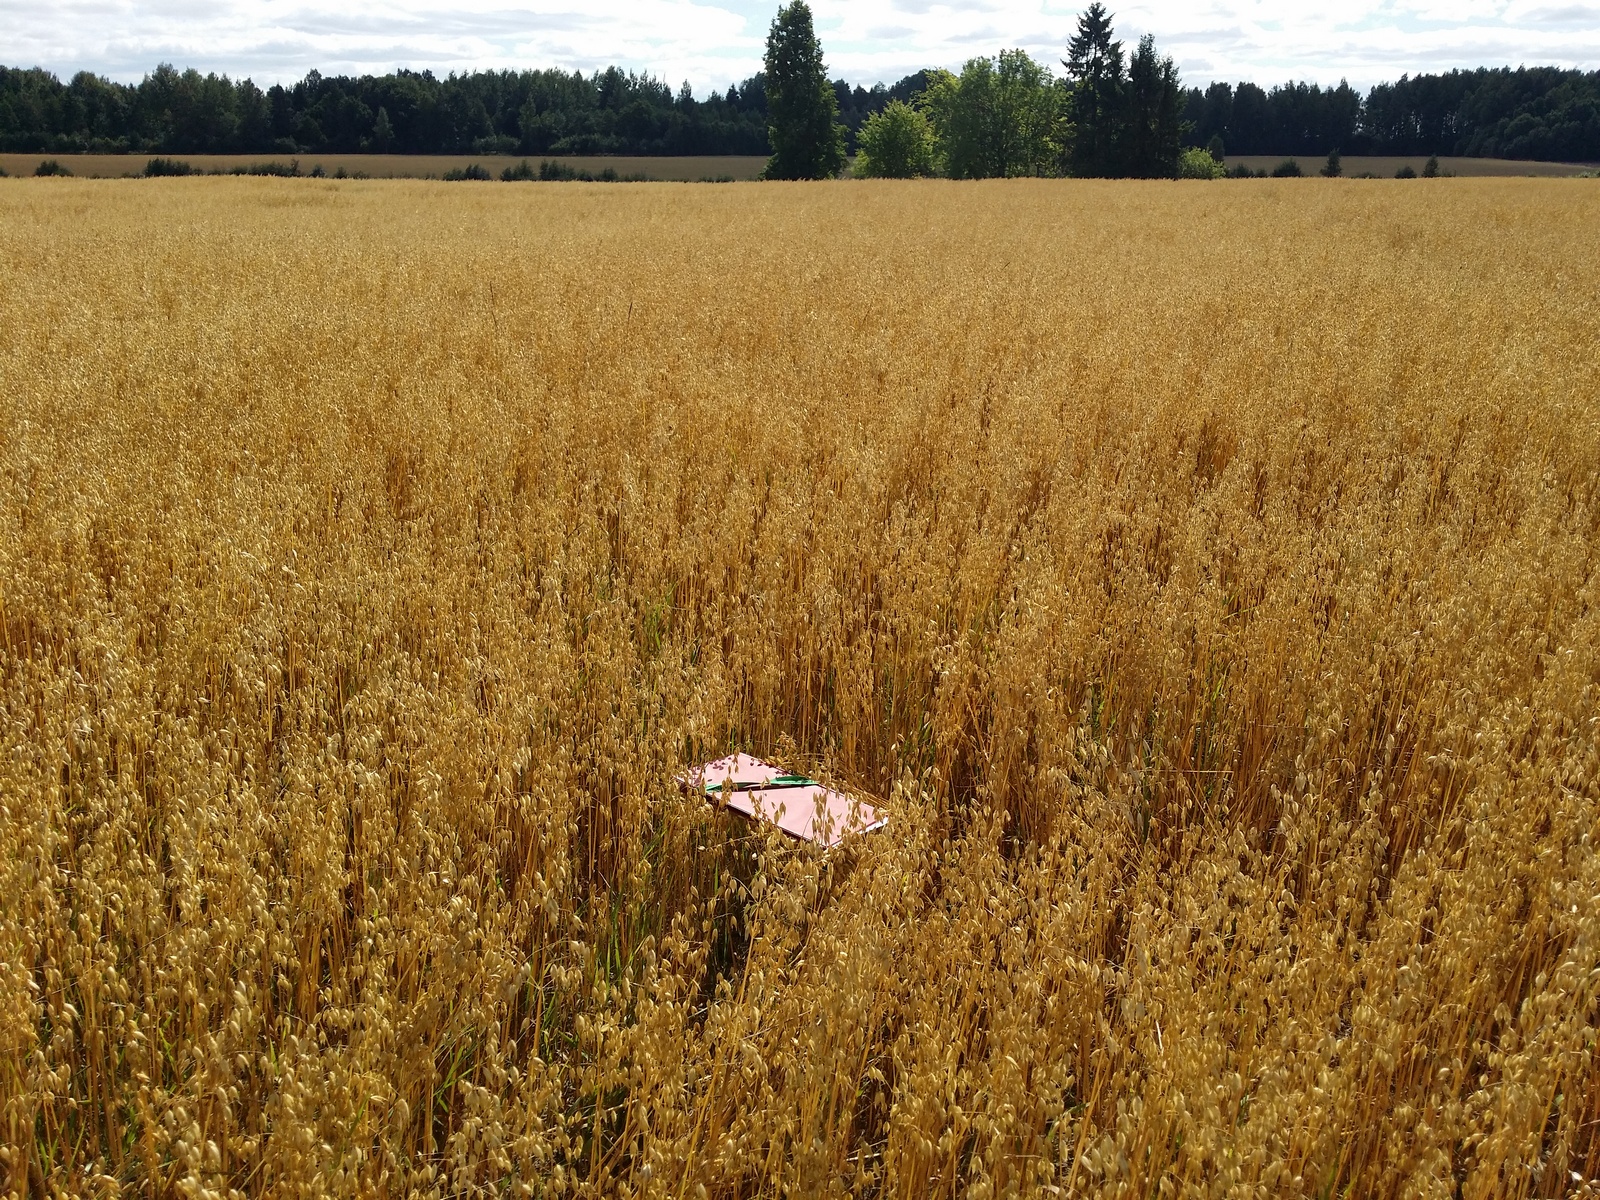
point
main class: Cropland
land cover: Oats
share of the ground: > 75 %
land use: Agriculture (excluding fallow land and kitchen gardens)
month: August
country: LV
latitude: 57.2422
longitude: 27.7657
